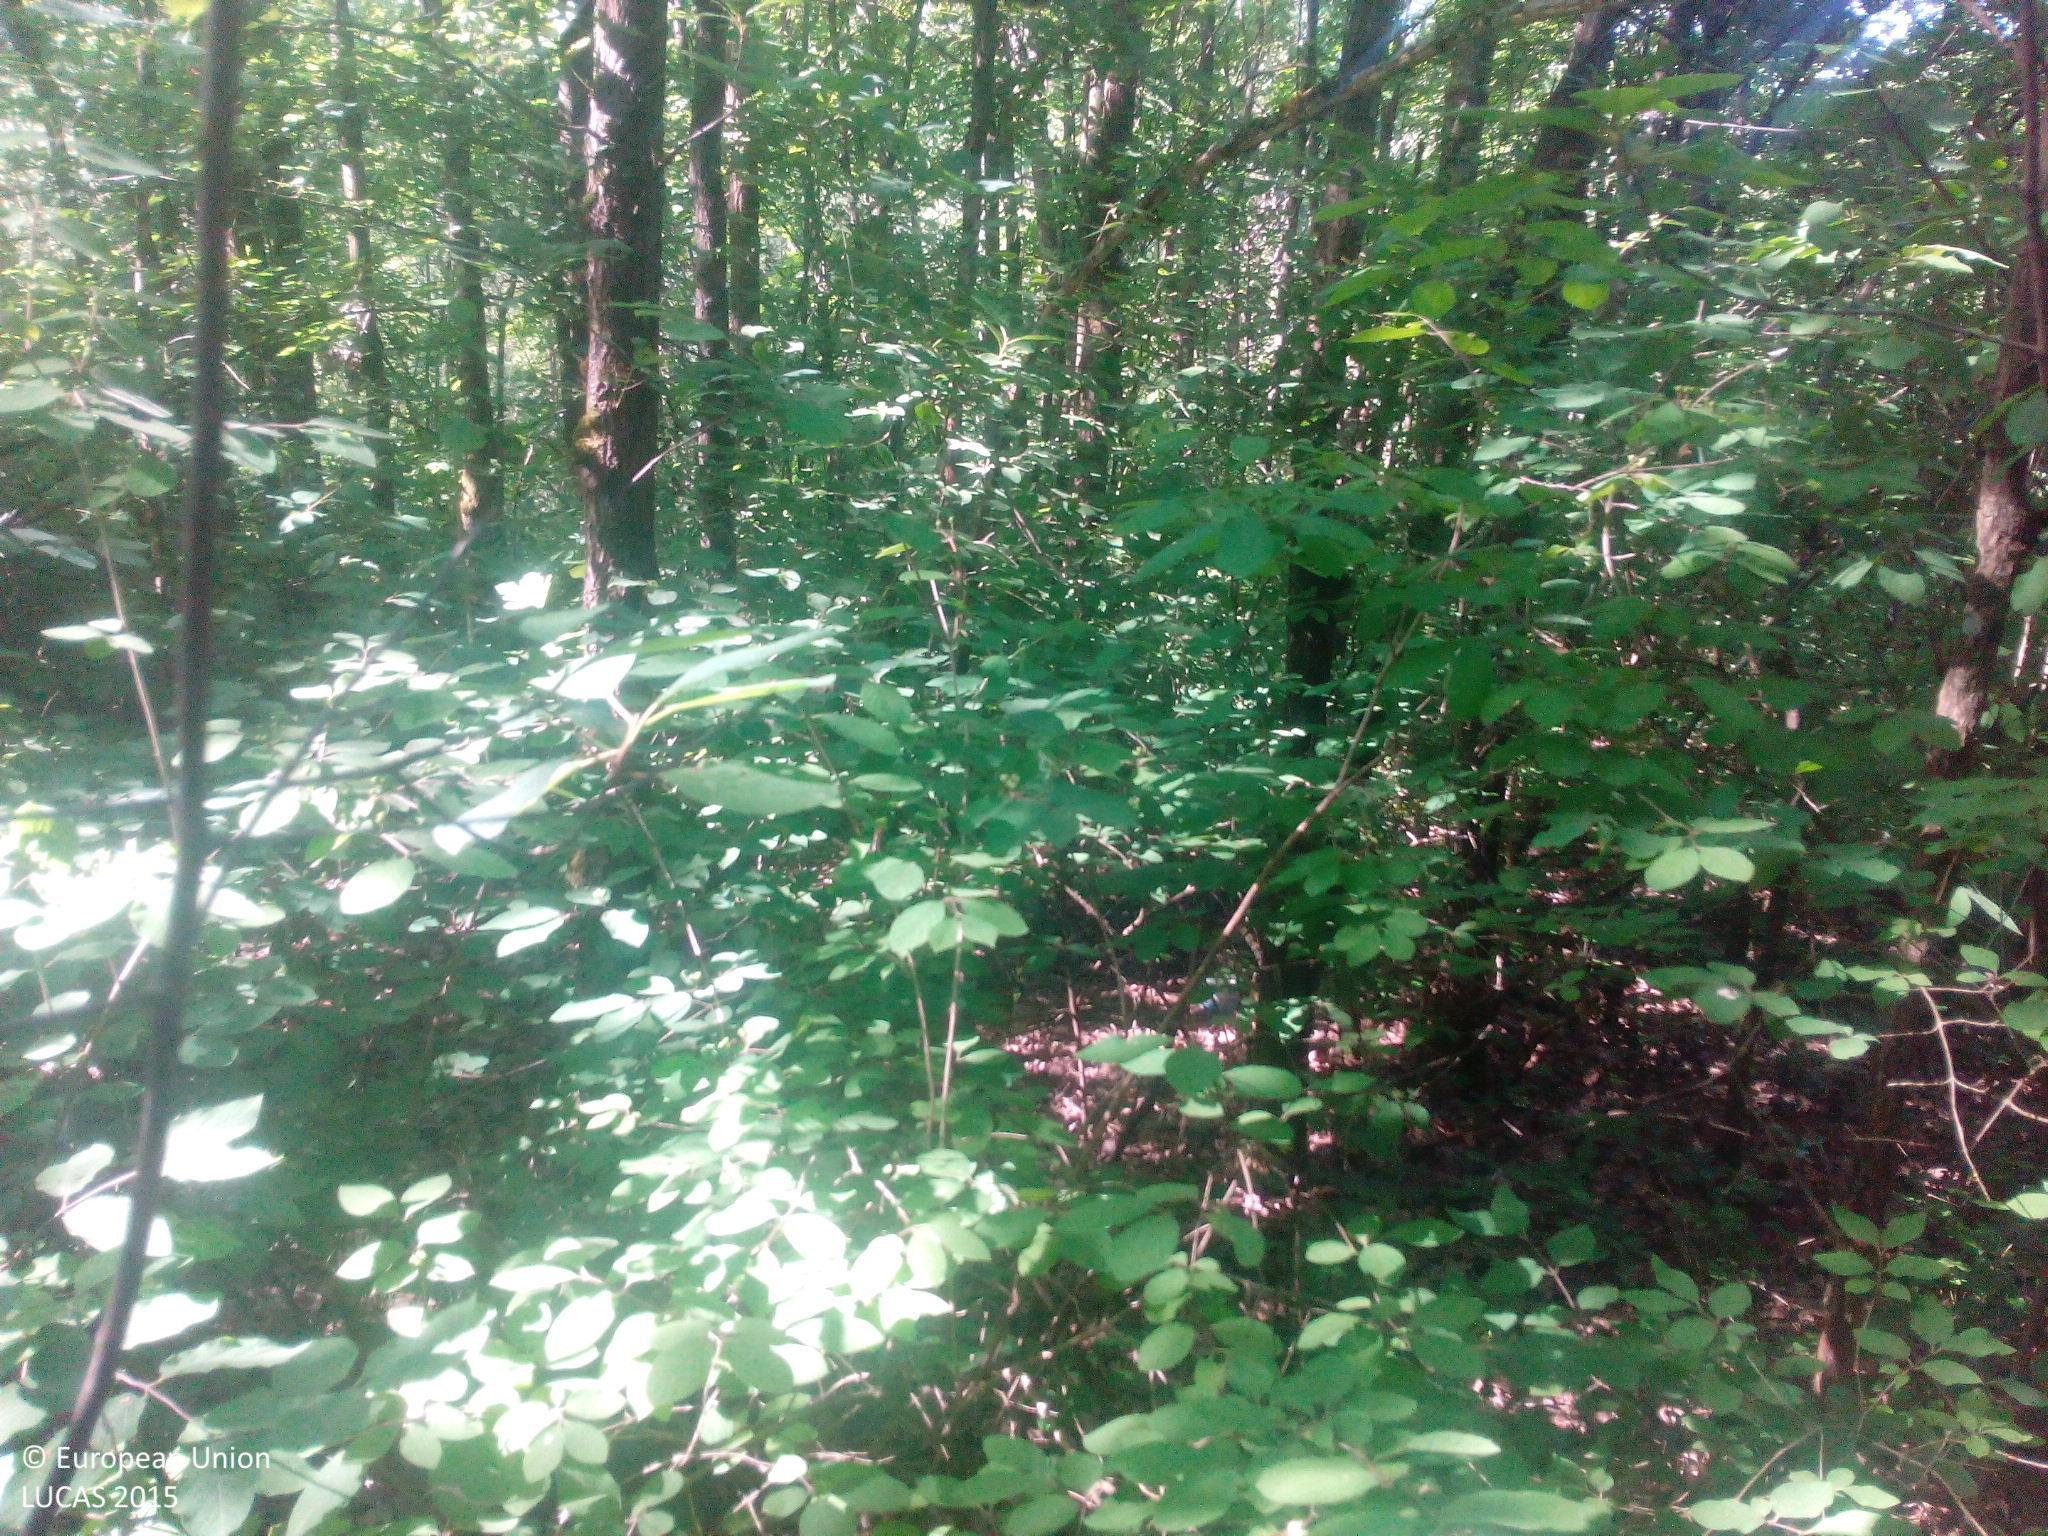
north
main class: Woodland
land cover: Broadleaved woodland
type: mesophytic deciduous forest
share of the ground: > 75 %
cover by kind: broadleaved forest trees 95 %, unconsolidated bare surface 5 %
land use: Semi-natural and natural areas not in use
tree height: > 5 m
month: June
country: DE
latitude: 49.3340
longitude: 11.0592
